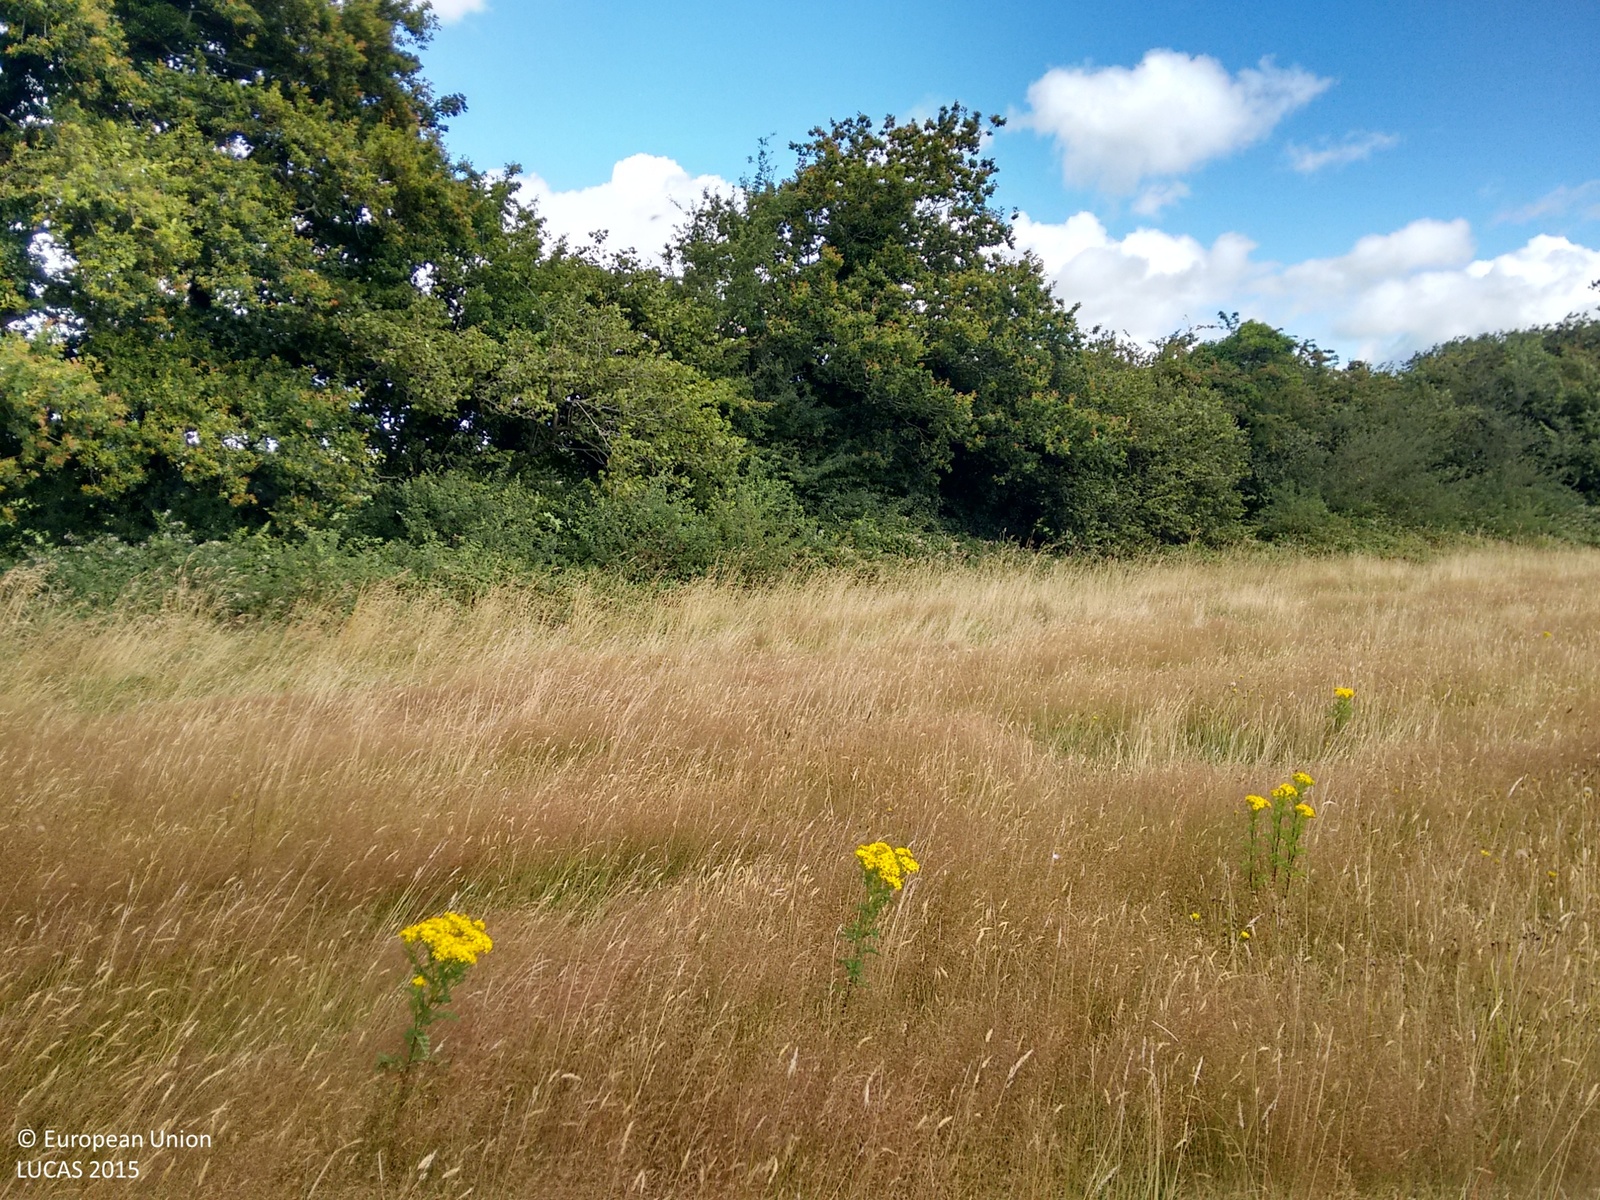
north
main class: Grassland
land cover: Grassland without tree/shrub cover
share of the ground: > 75 %
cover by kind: herbaceous plants 100 %
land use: Agriculture (excluding fallow land and kitchen gardens)
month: August
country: IE
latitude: 52.3254
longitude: -7.1837
